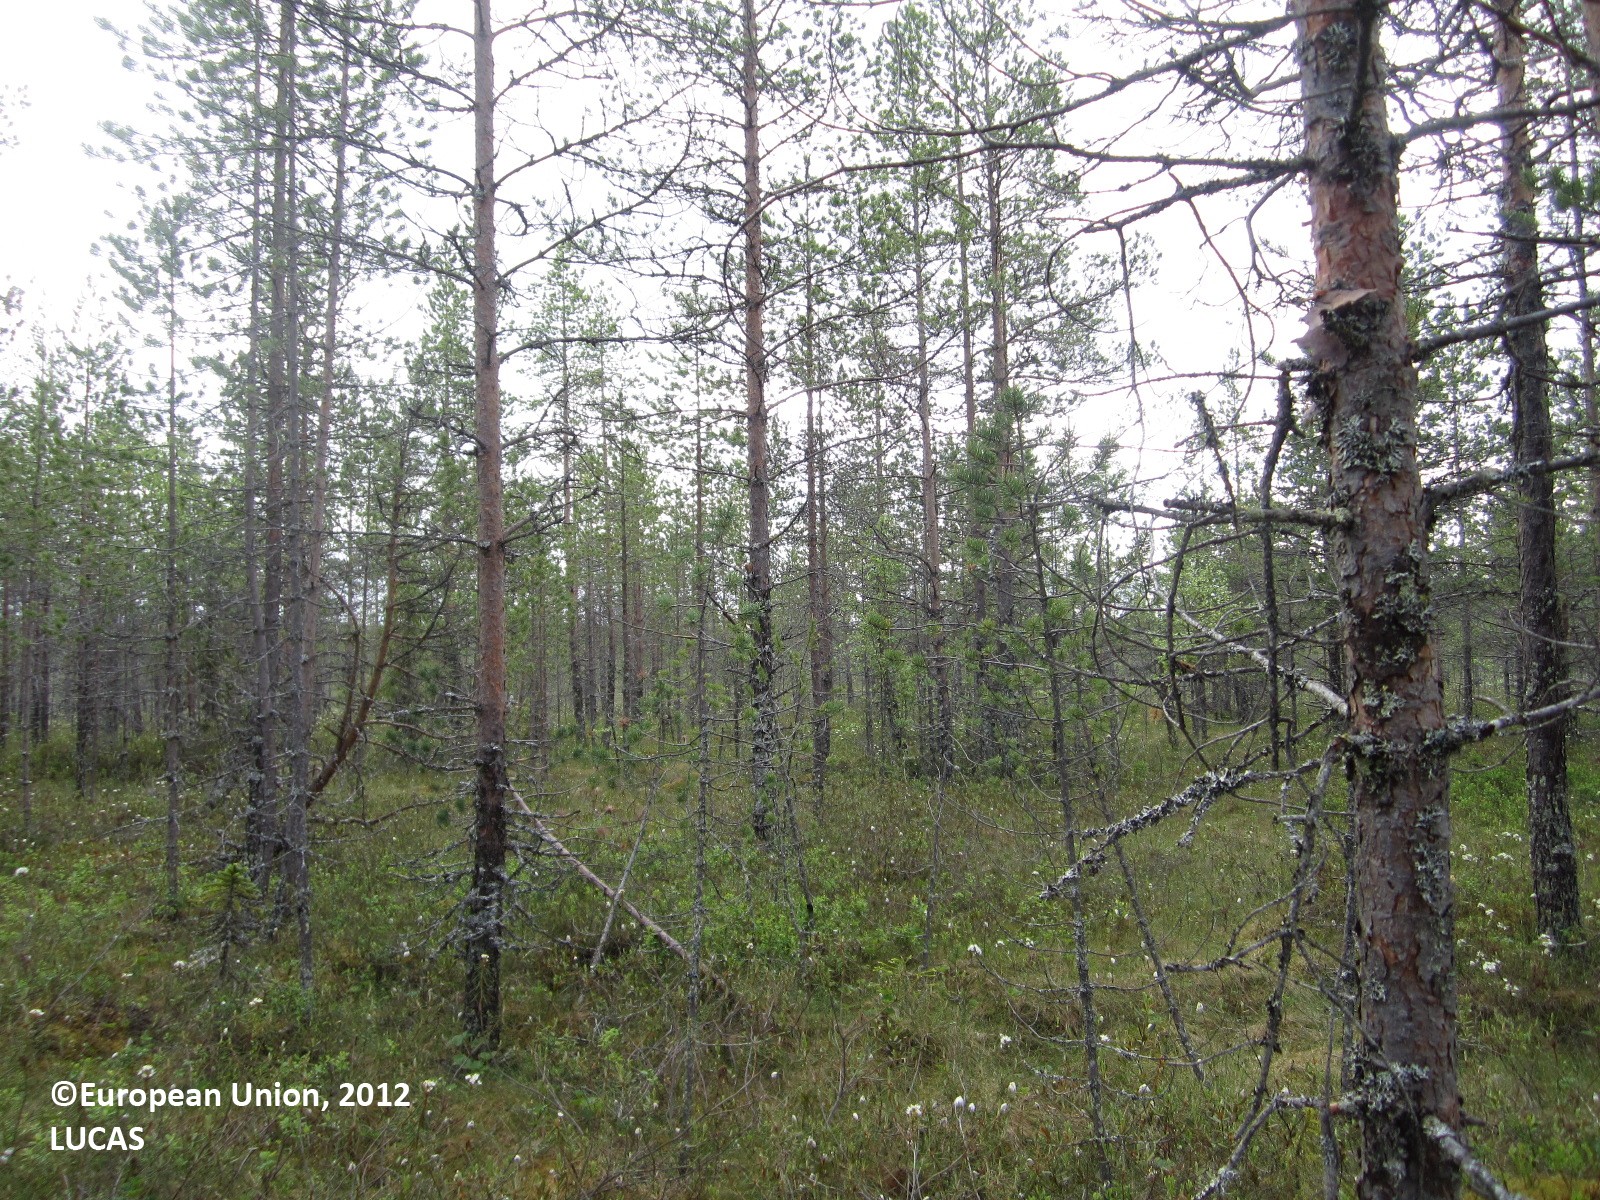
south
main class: Woodland
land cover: Pine dominated coniferous woodland
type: boreal forest
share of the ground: 50 - 75 %
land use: Forestry
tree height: > 5 m
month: June
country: FI
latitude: 64.4158
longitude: 29.7118
